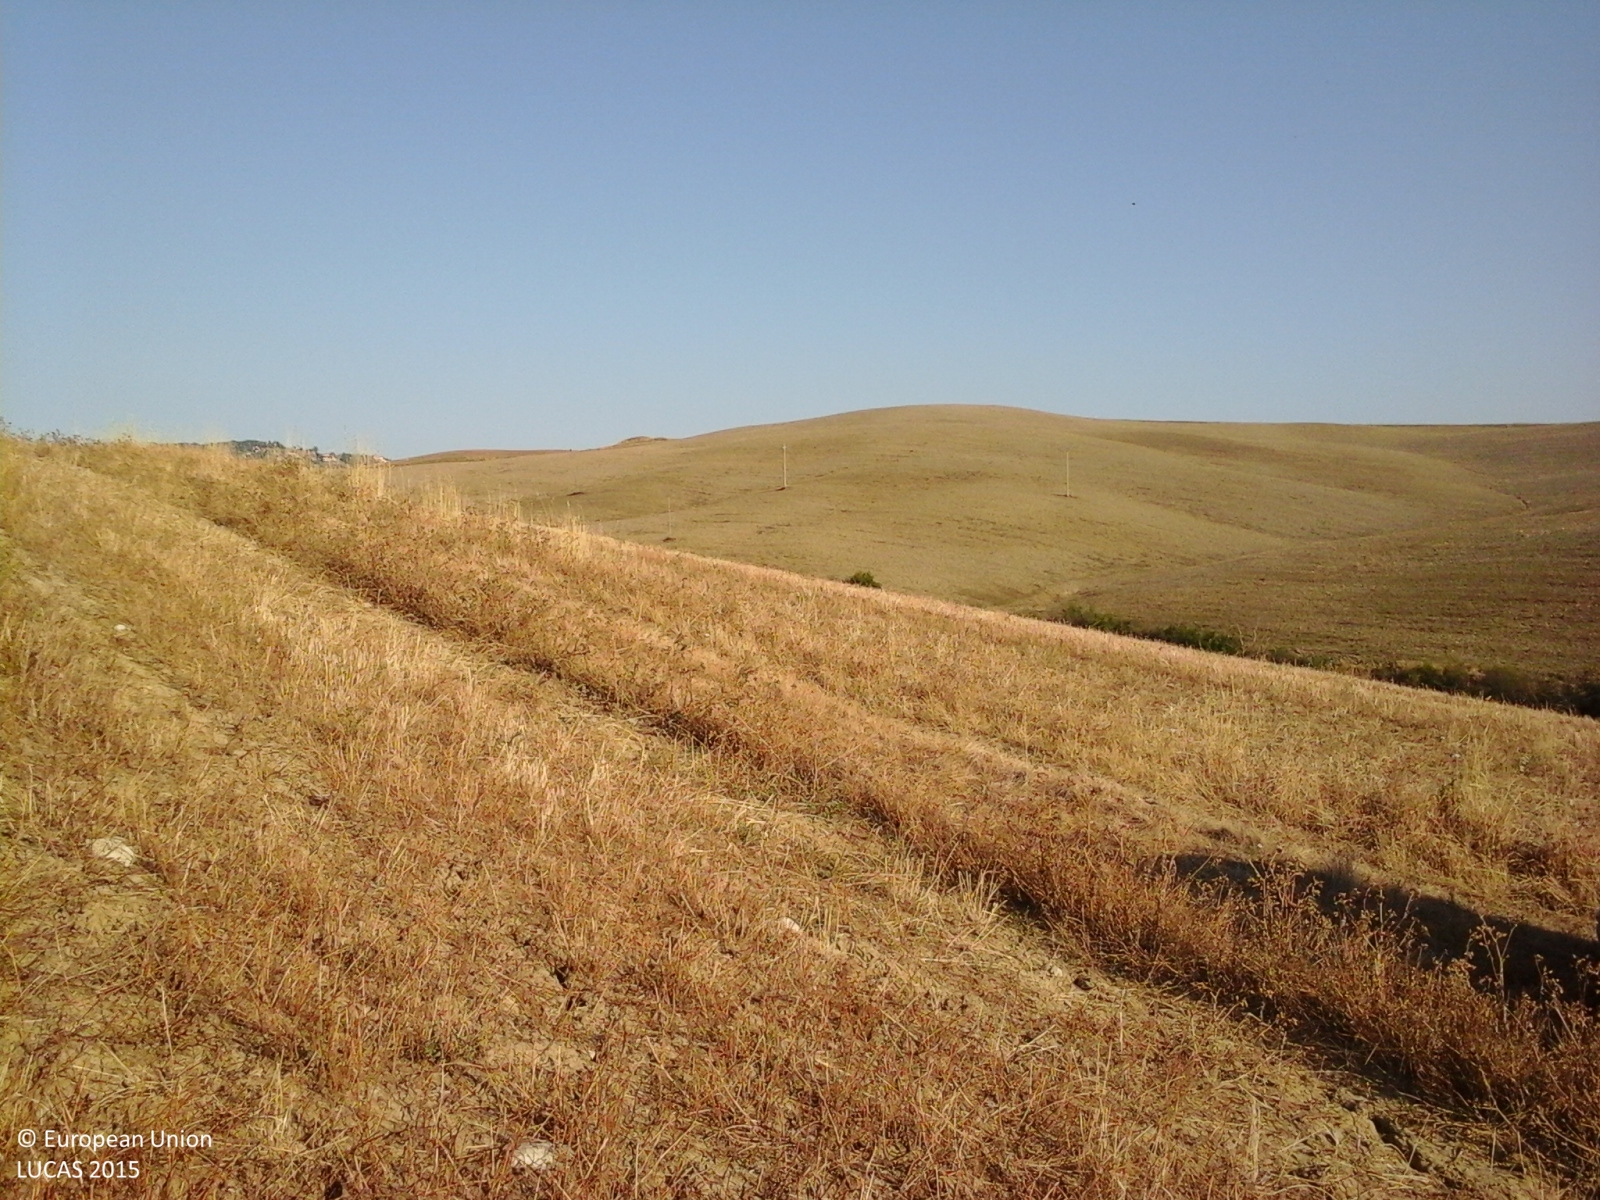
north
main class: Cropland
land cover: Lucerne
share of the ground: > 75 %
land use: Agriculture (excluding fallow land and kitchen gardens)
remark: Harvested field
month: August
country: IT
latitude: 42.9838
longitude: 11.6505
